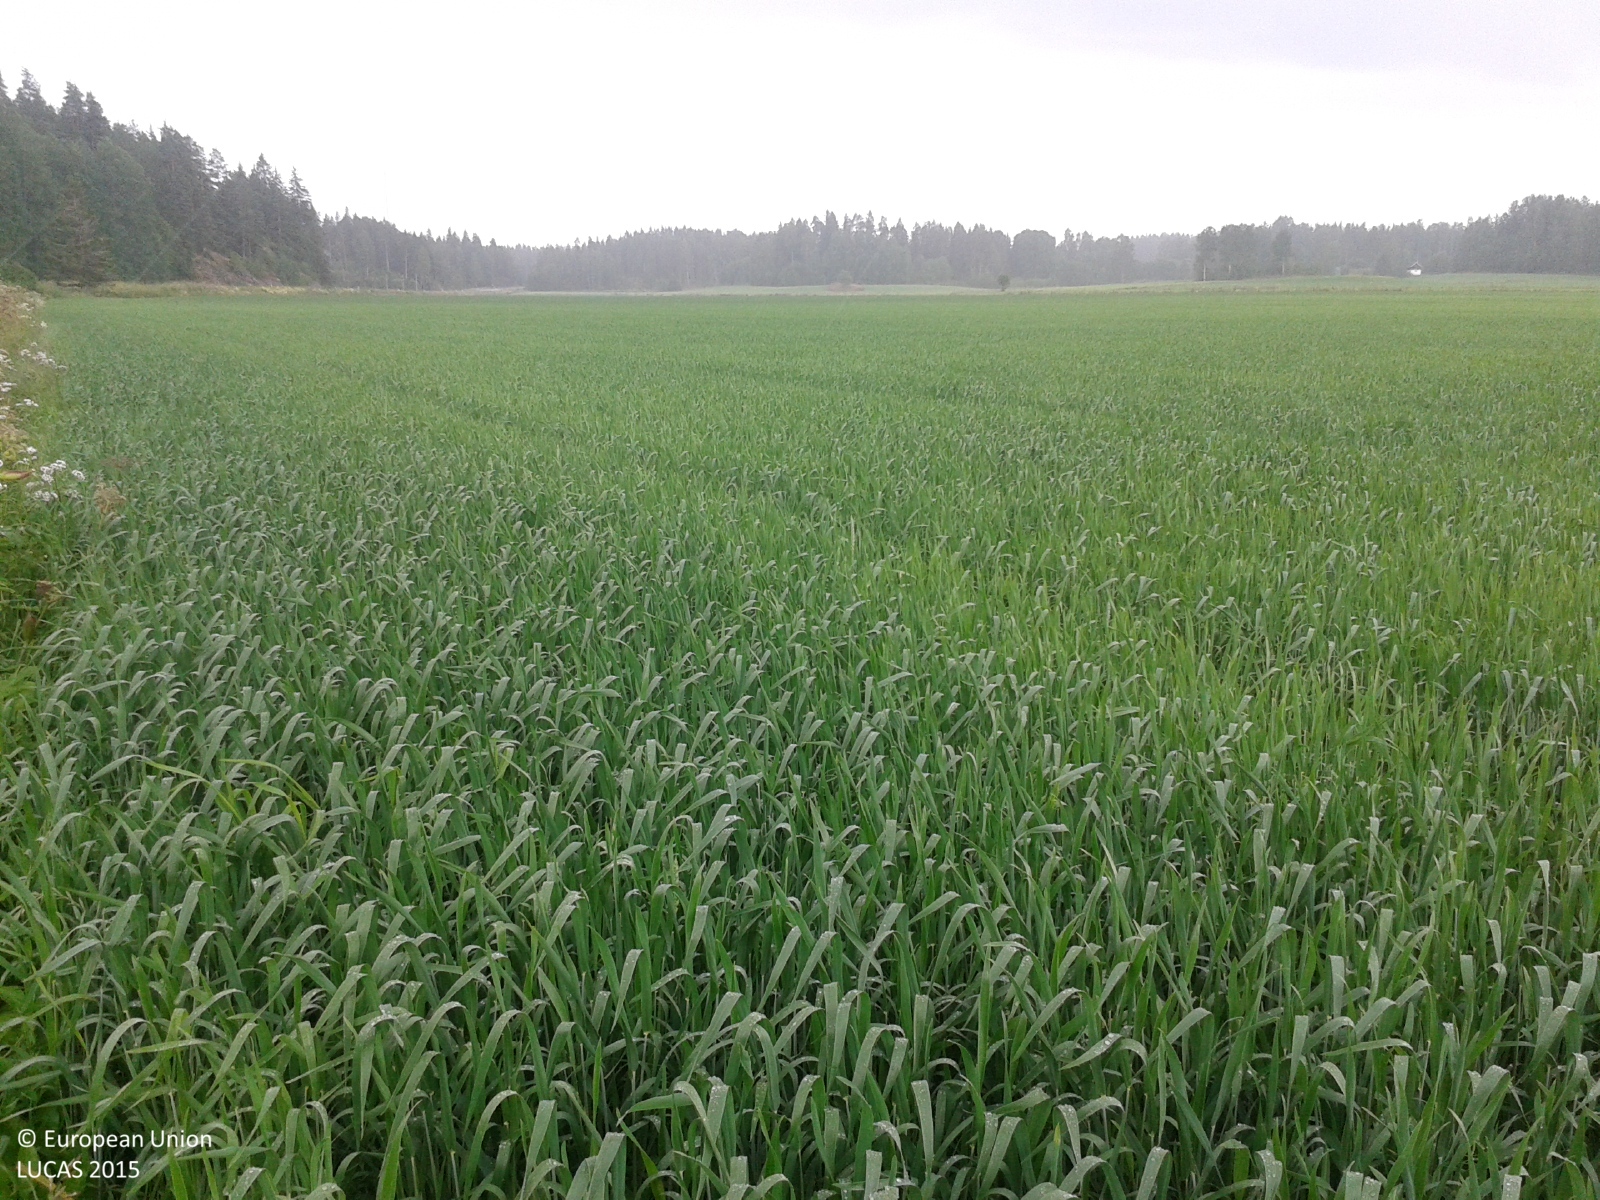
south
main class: Cropland
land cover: Barley
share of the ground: > 75 %
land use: Agriculture (excluding fallow land and kitchen gardens)
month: July
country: FI
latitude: 60.0865
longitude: 23.9585
